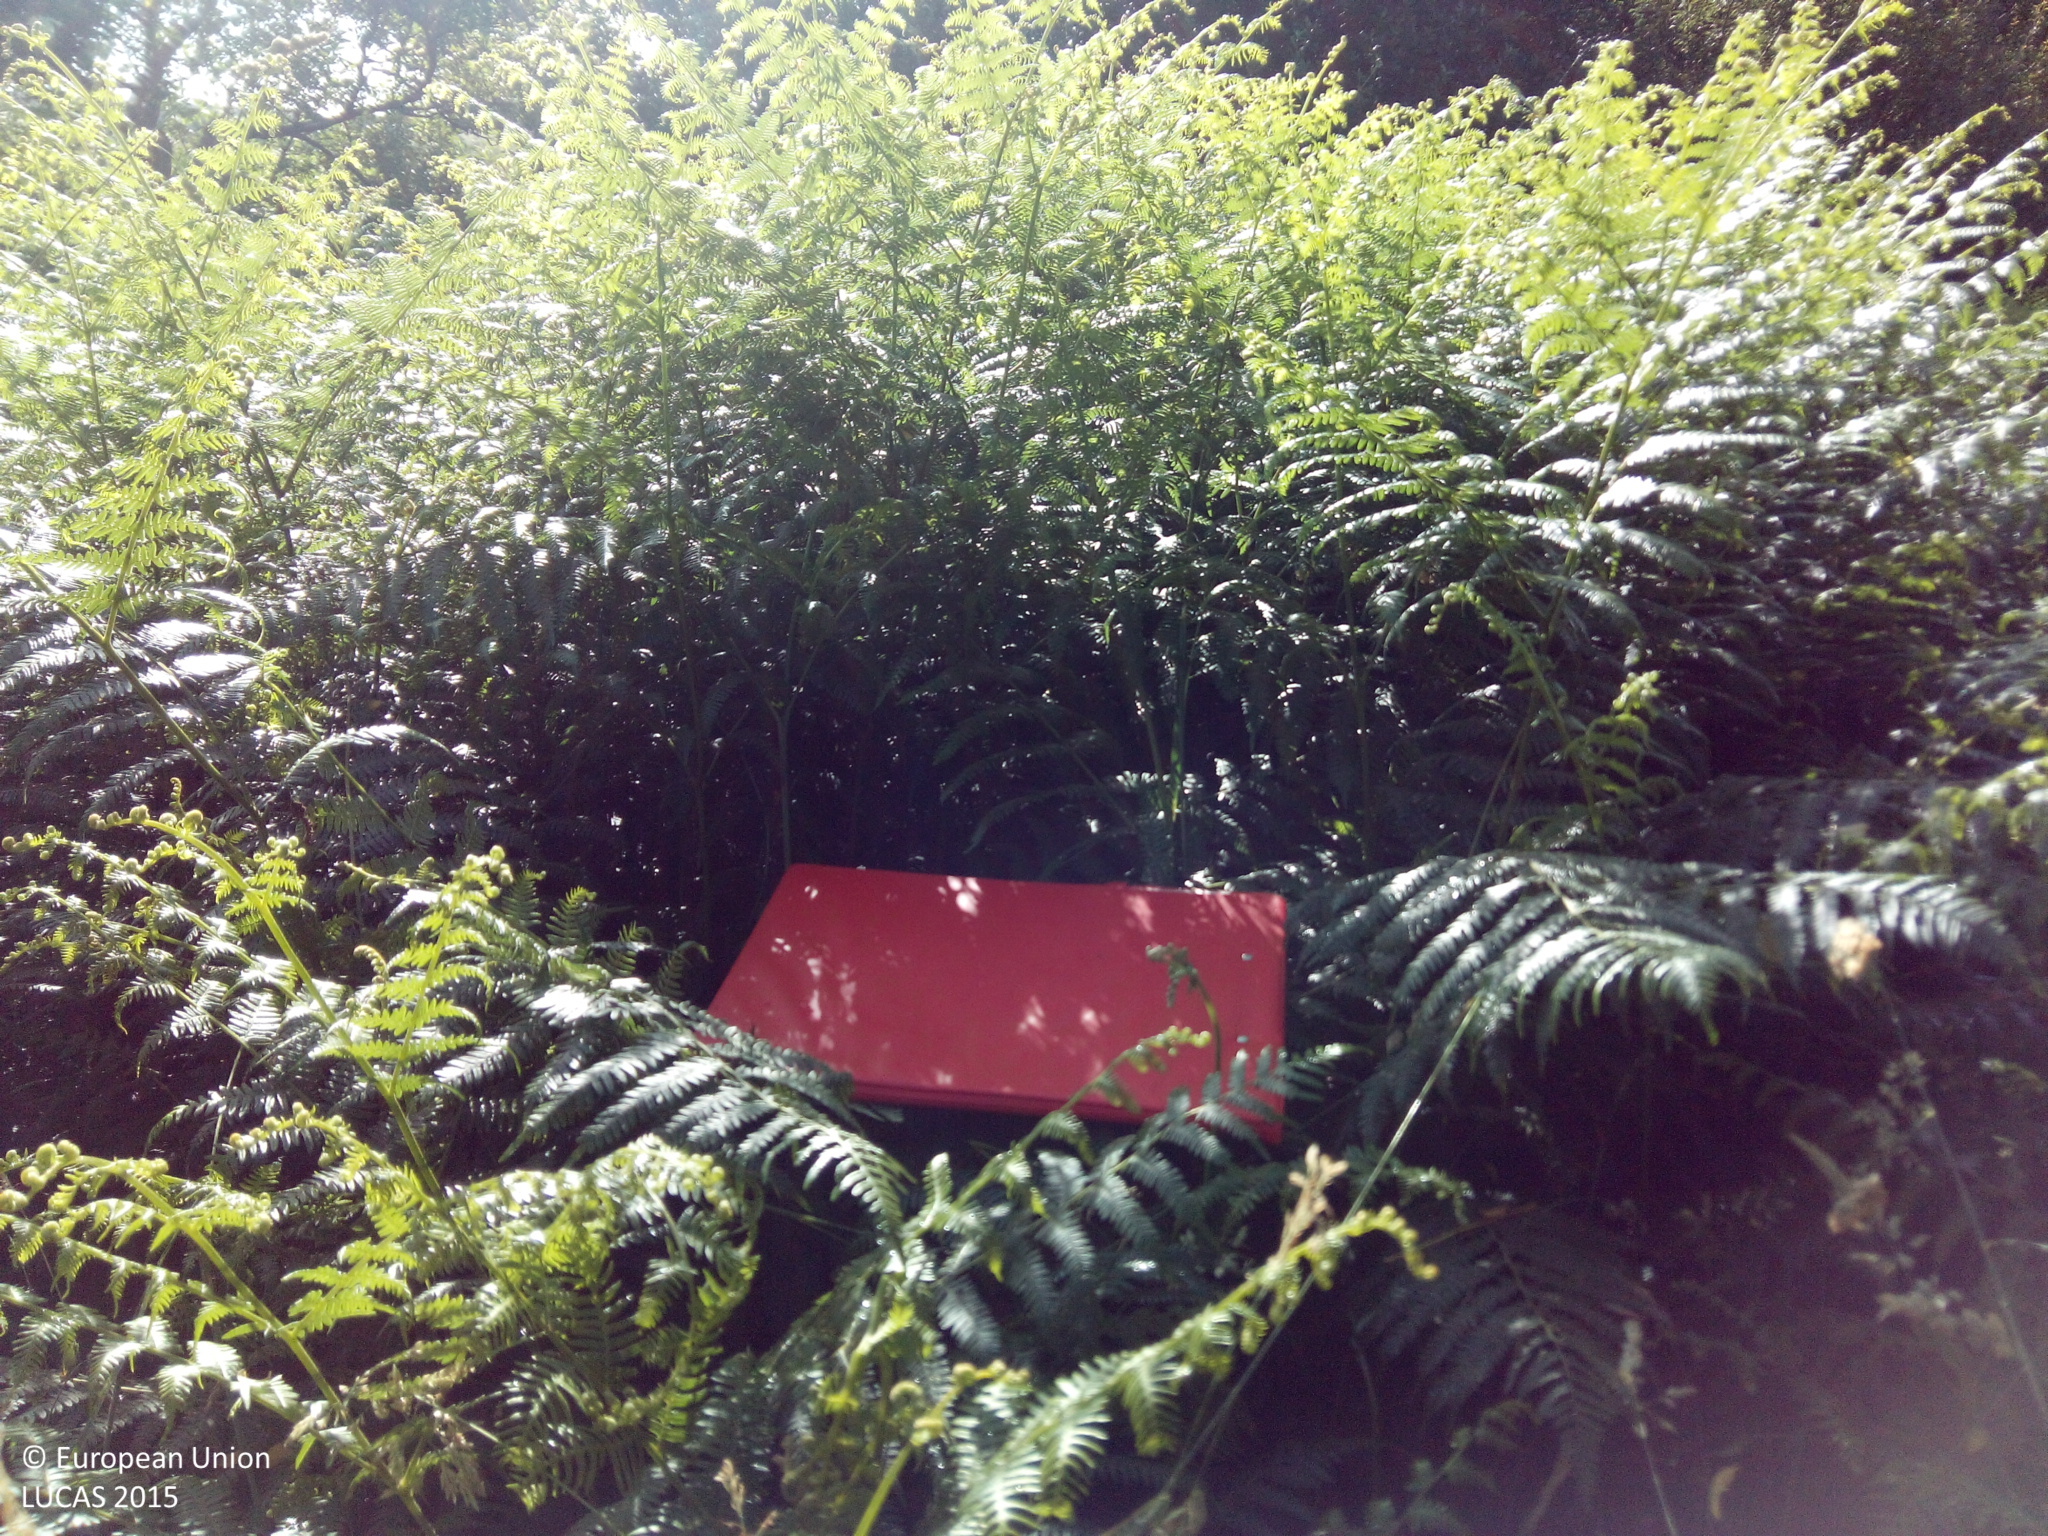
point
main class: Grassland
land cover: Grassland with sparse tree/shrub cover
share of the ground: > 75 %
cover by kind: herbaceous plants 95 %, coniferous forest trees 5 %
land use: Abandoned areas
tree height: < 5 m
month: July
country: ES
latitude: 42.3222
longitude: -8.2781
